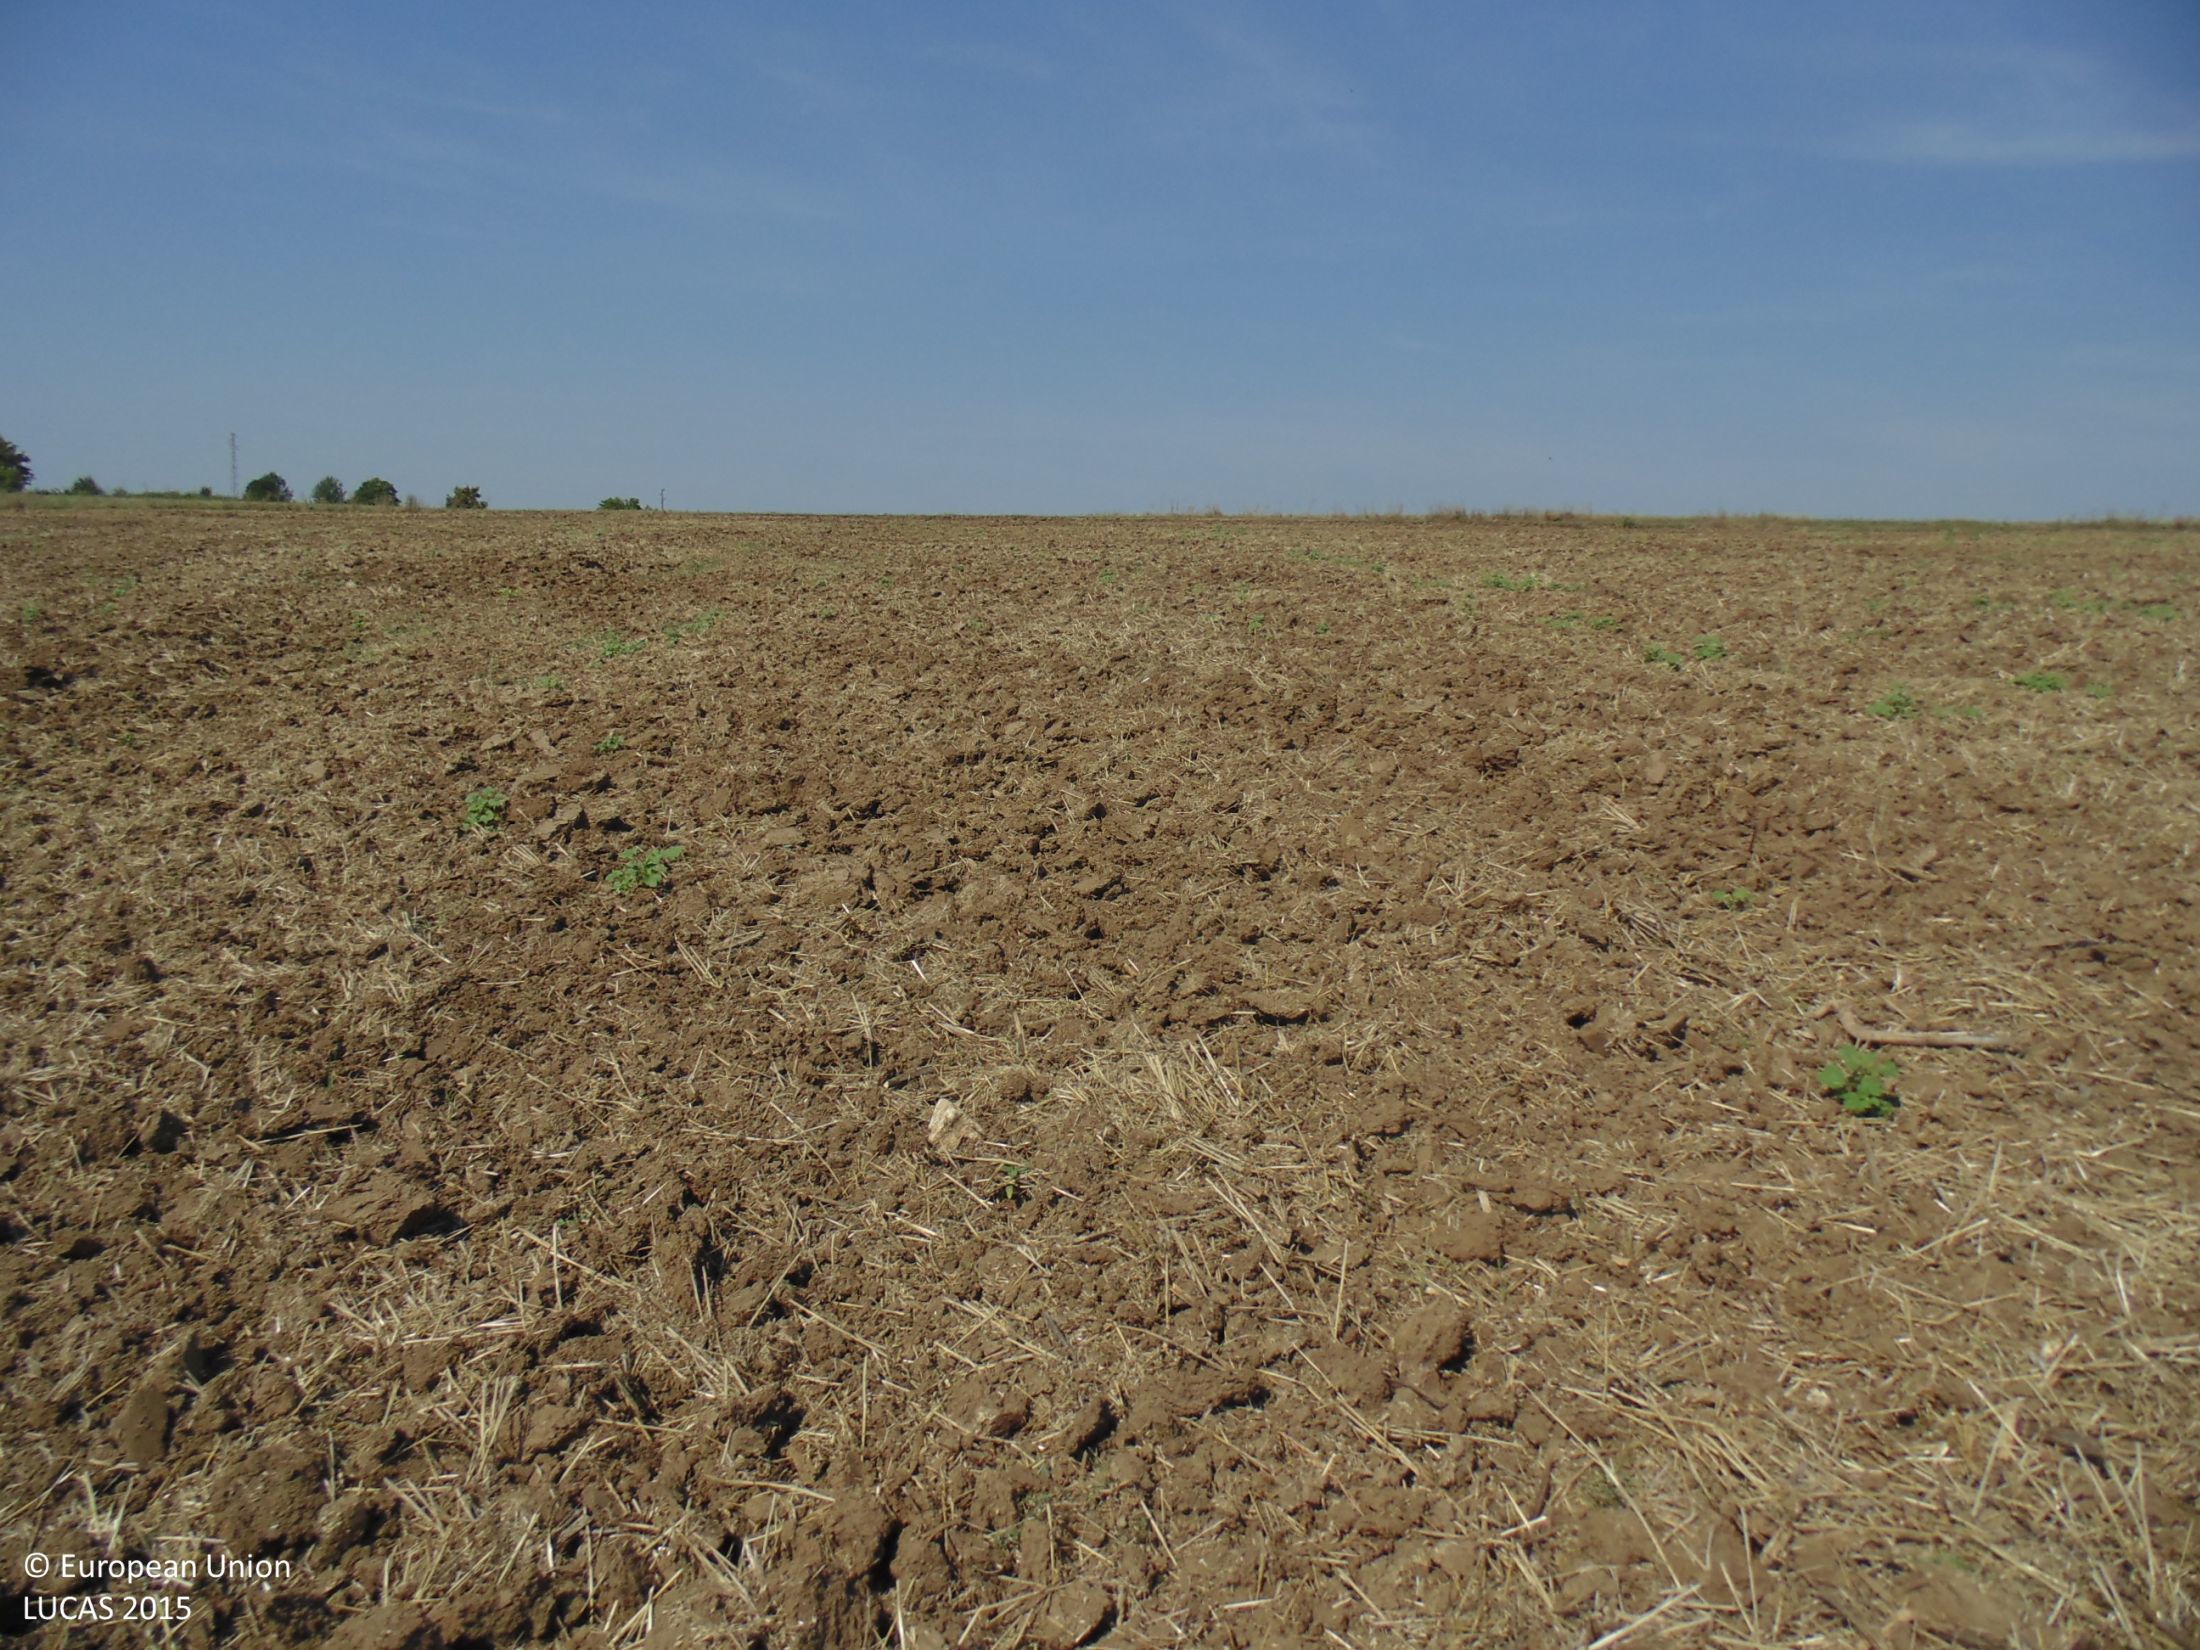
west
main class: Cropland
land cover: Common wheat
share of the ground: < 10 %
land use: Agriculture (excluding fallow land and kitchen gardens)
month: September
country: BG
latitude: 43.7631
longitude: 27.0015
